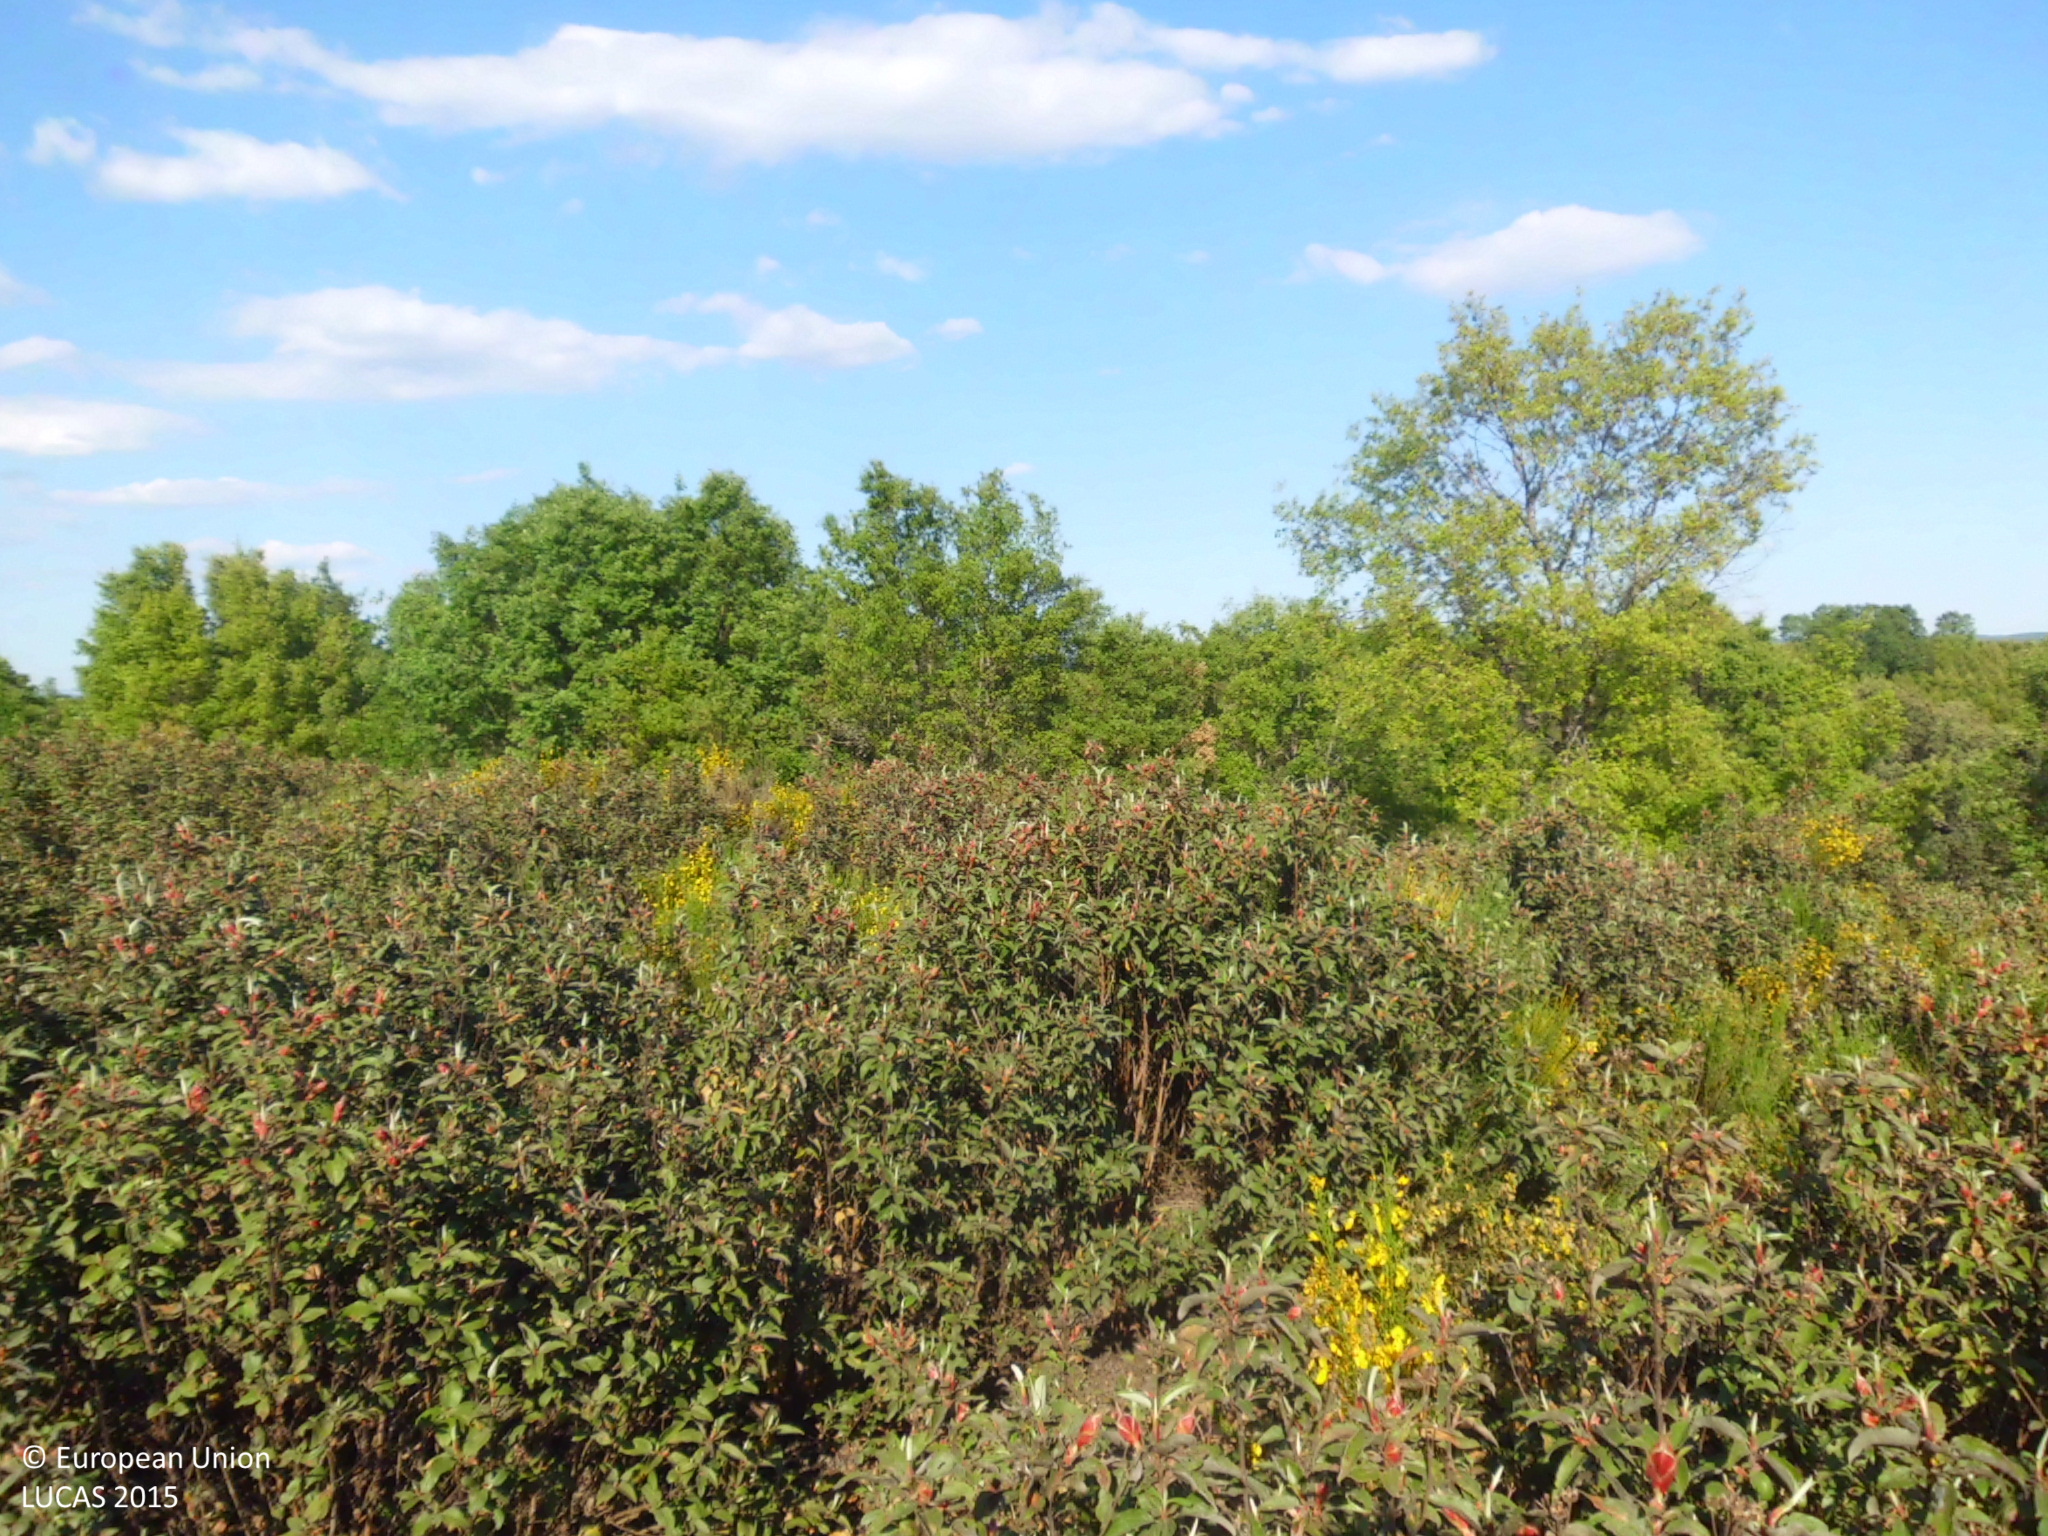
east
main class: Shrubland
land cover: Shrubland with sparse tree cover
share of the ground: 50 - 75 %
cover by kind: shrubs 55 %, herbaceous plants 20 %, unconsolidated bare surface 20 %, coniferous forest trees 5 %
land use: Forestry
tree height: < 5 m
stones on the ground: > 50 %
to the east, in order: Shrubland with sparse tree cover; Broadleaved woodland; Tracks; Other mixed woodland
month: May
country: ES
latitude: 42.6740
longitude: -5.4337
